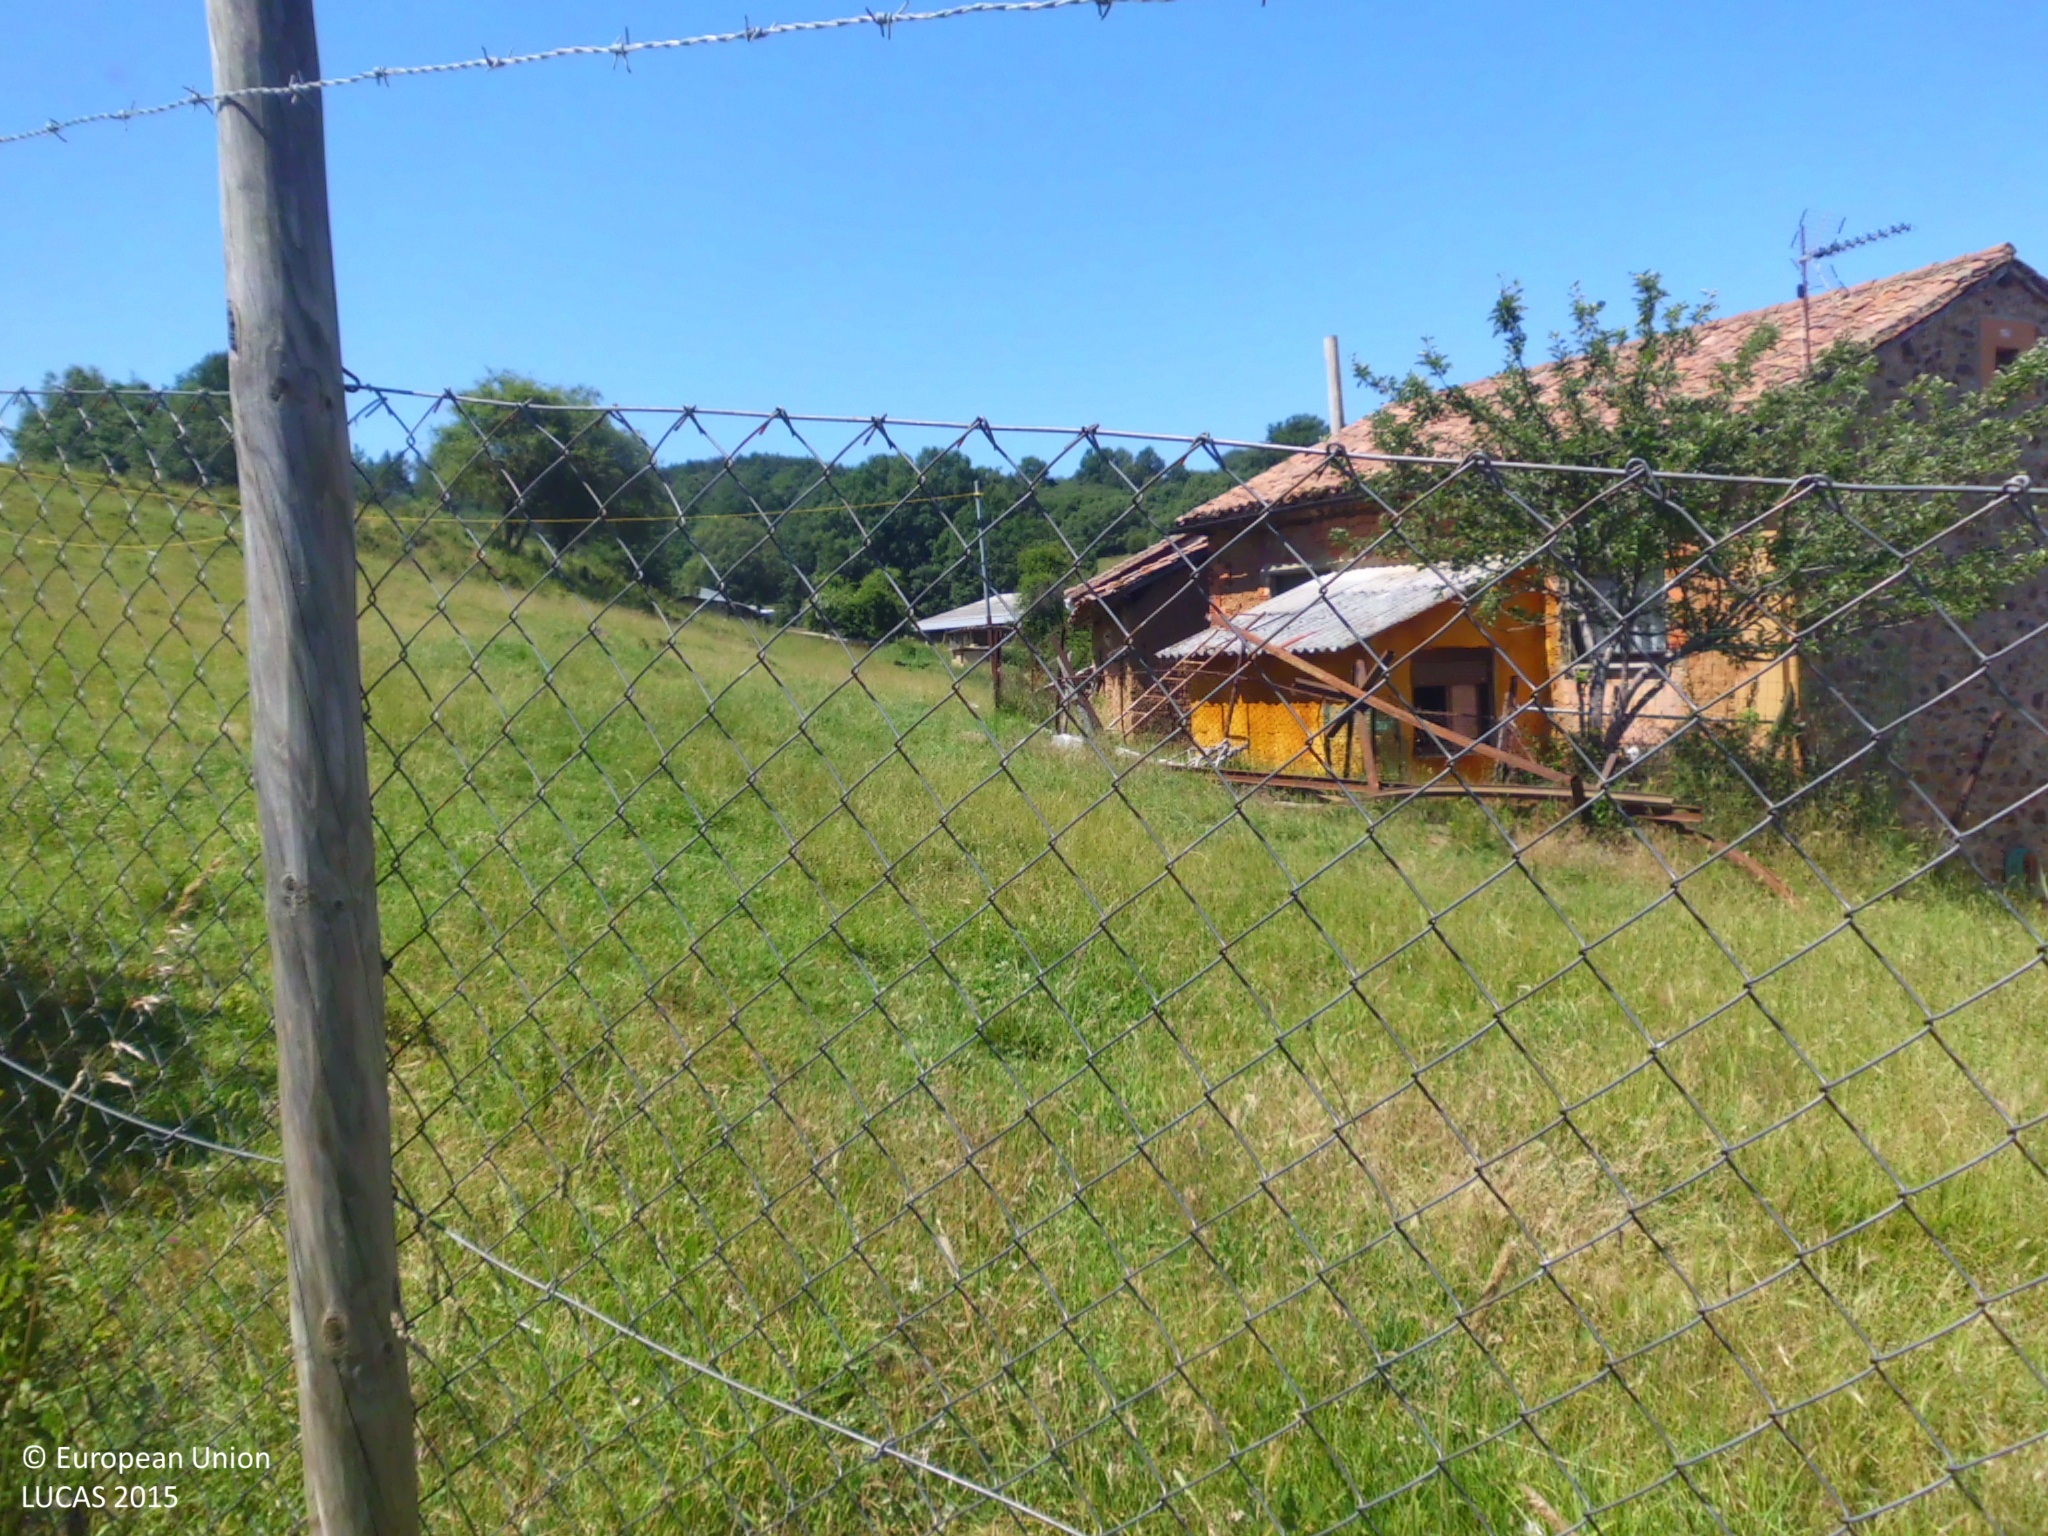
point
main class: Grassland
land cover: Grassland with sparse tree/shrub cover
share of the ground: > 75 %
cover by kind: herbaceous plants 80 %, unconsolidated bare surface 15 %, broadleaved forest trees 5 %
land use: Agriculture (excluding fallow land and kitchen gardens)
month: June
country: ES
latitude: 42.7855
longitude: -4.9393
